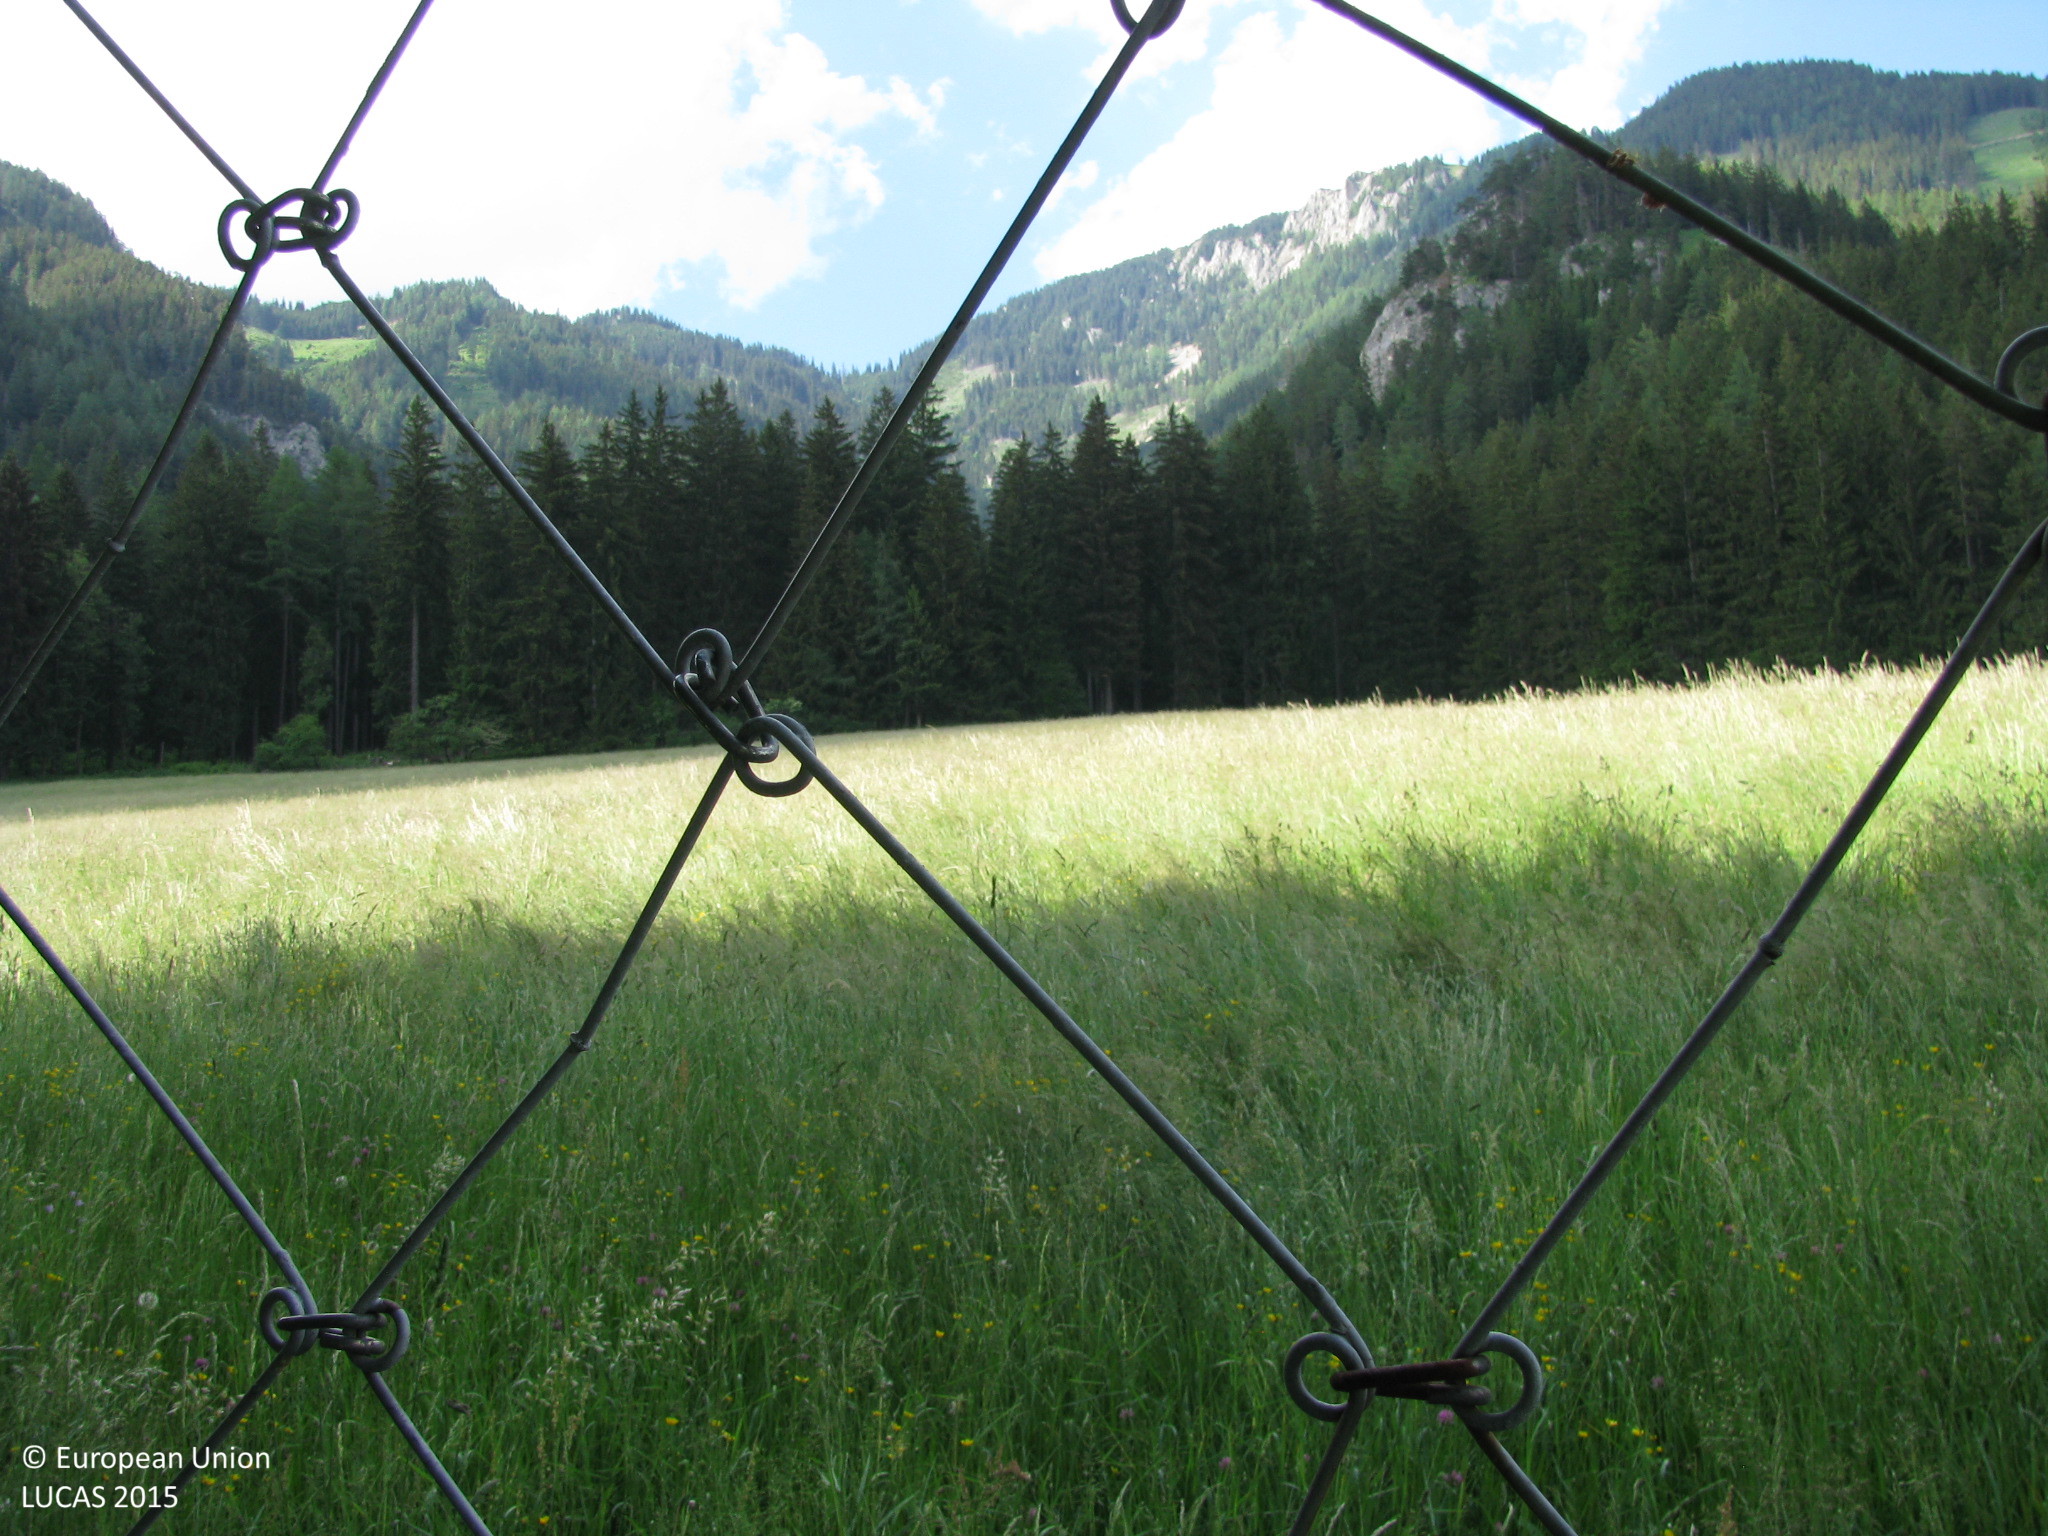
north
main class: Grassland
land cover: Grassland without tree/shrub cover
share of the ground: > 75 %
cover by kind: herbaceous plants 100 %
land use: Agriculture (excluding fallow land and kitchen gardens)
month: June
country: AT
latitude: 47.3939
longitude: 14.8883
